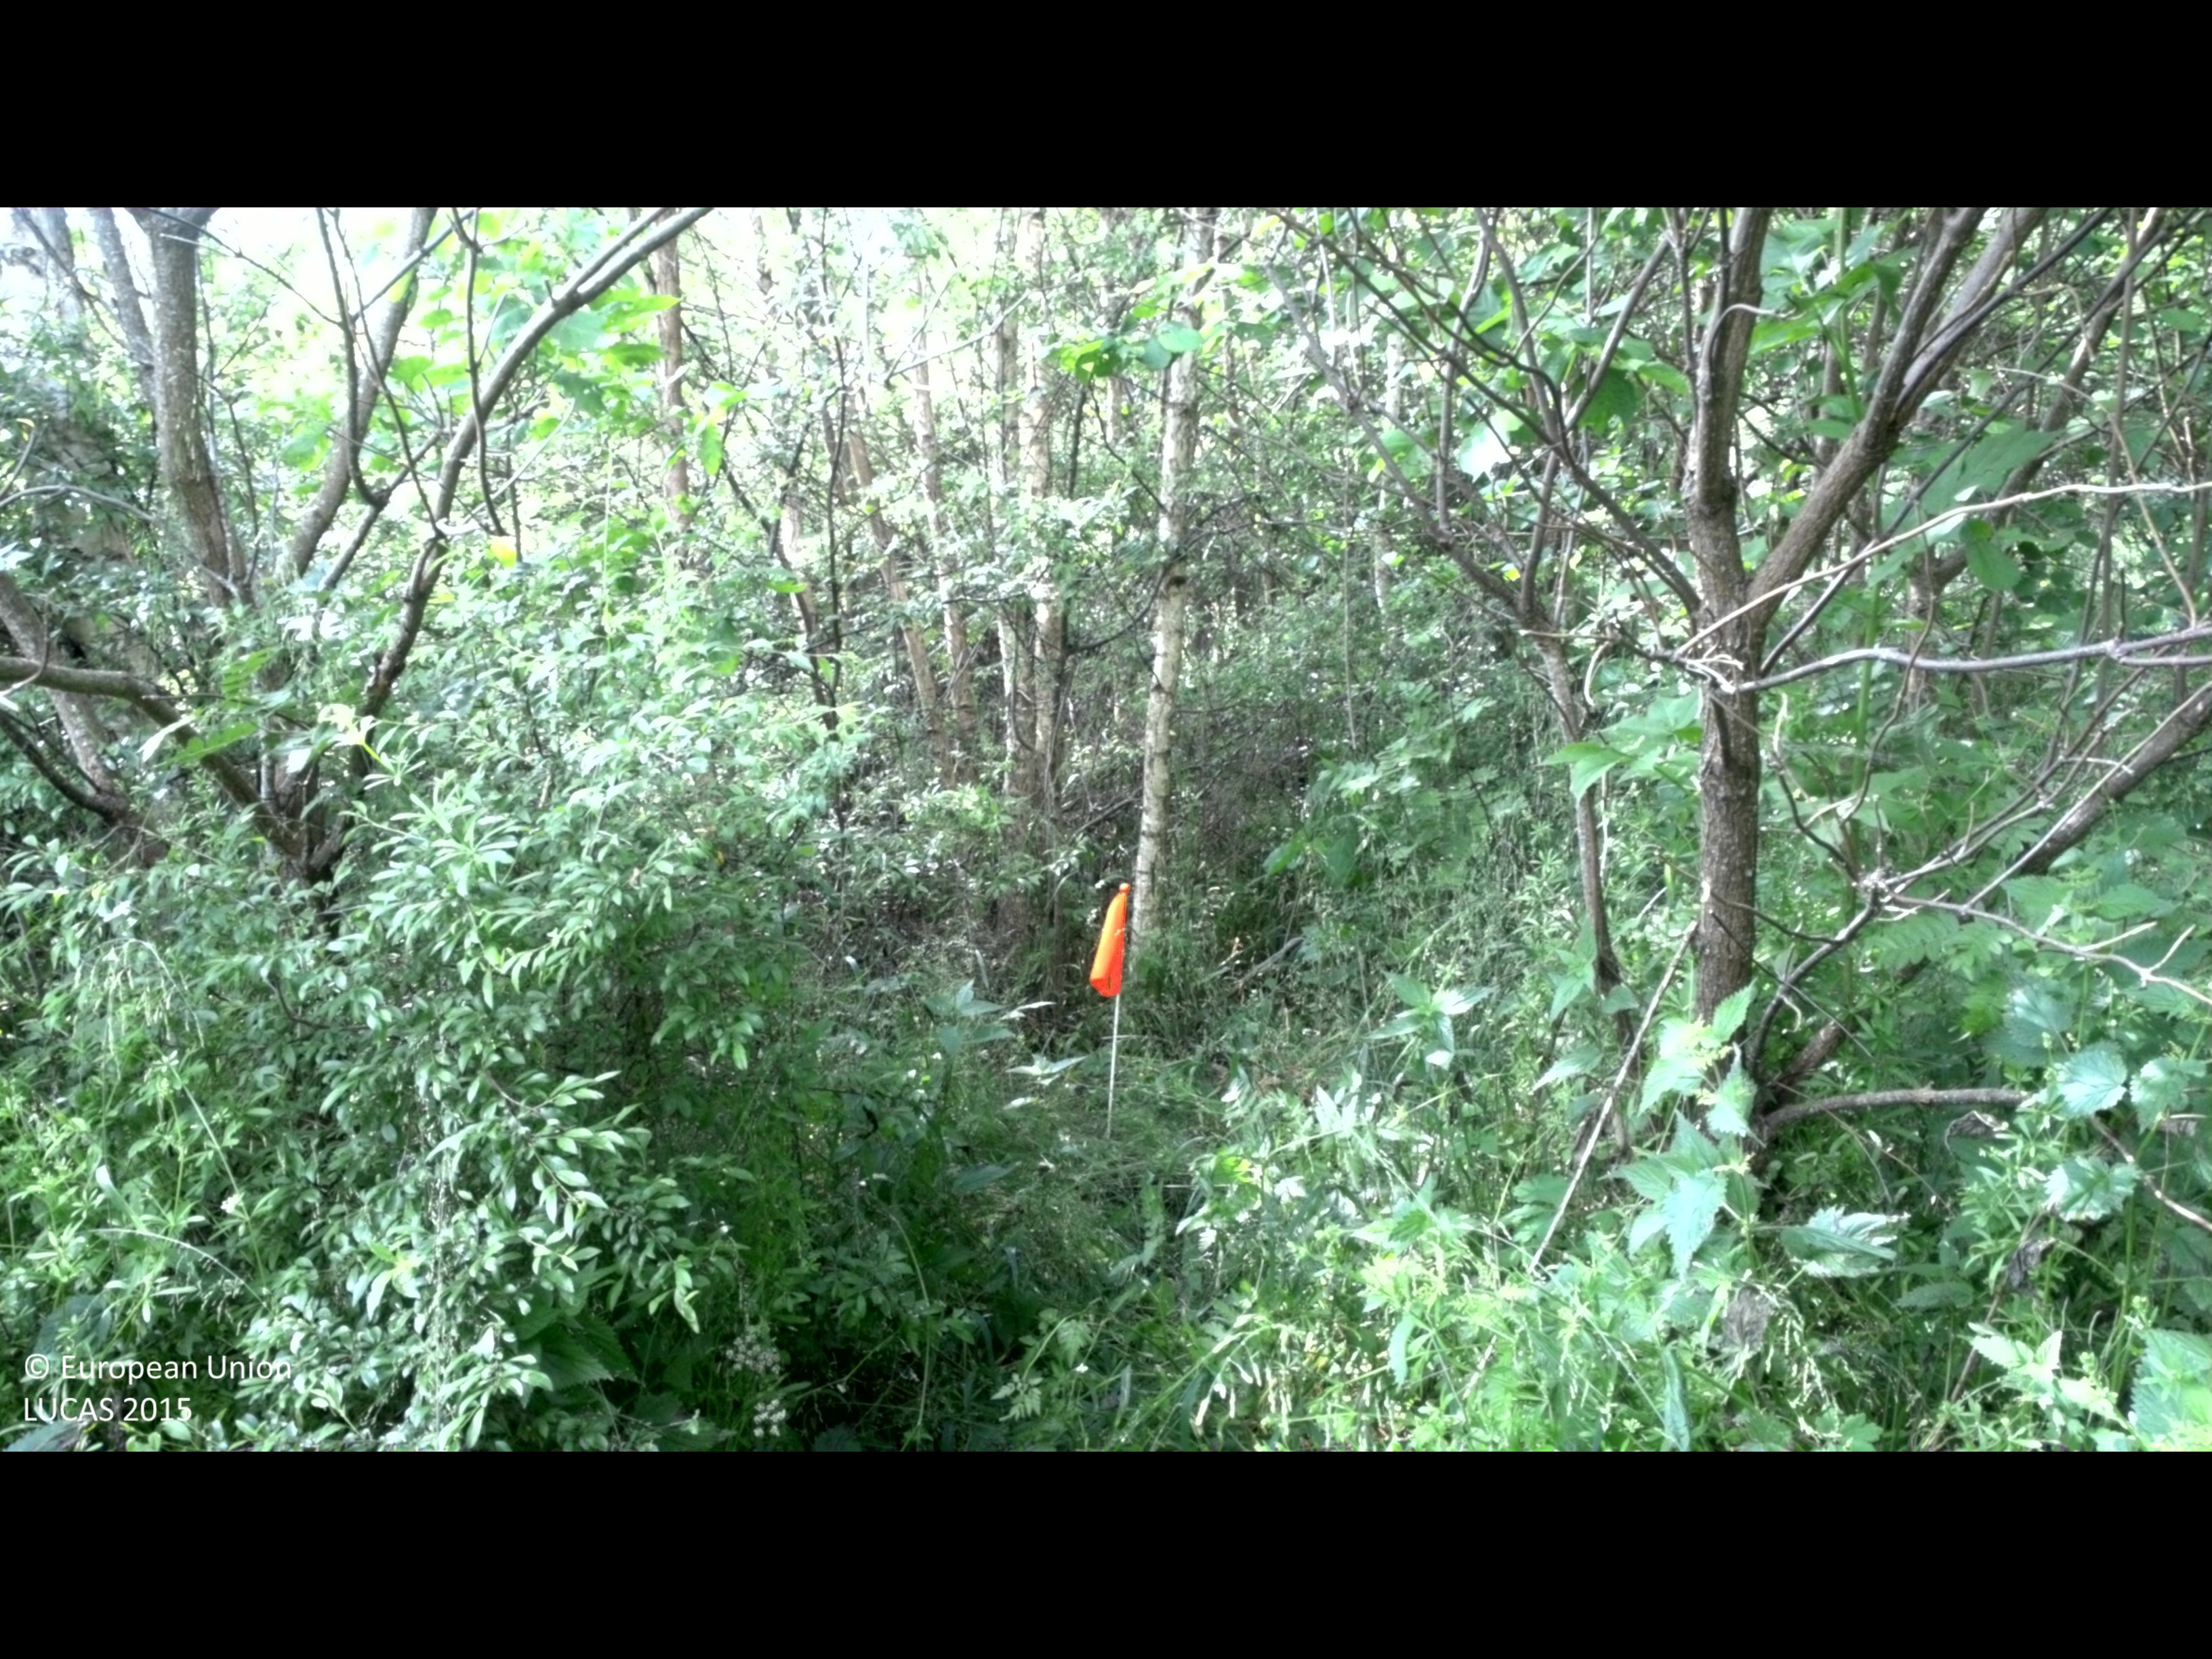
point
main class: Woodland
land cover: Broadleaved woodland
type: hemiboreal forest and nemoral coniferous forest and mixed broadleaved-coniferous forest
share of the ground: 25 - 50 %
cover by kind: shrubs 45 %, broadleaved forest trees 40 %, herbaceous plants 15 %
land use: Forestry
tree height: > 5 m
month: June
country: SE
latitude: 57.8918
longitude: 16.6615
